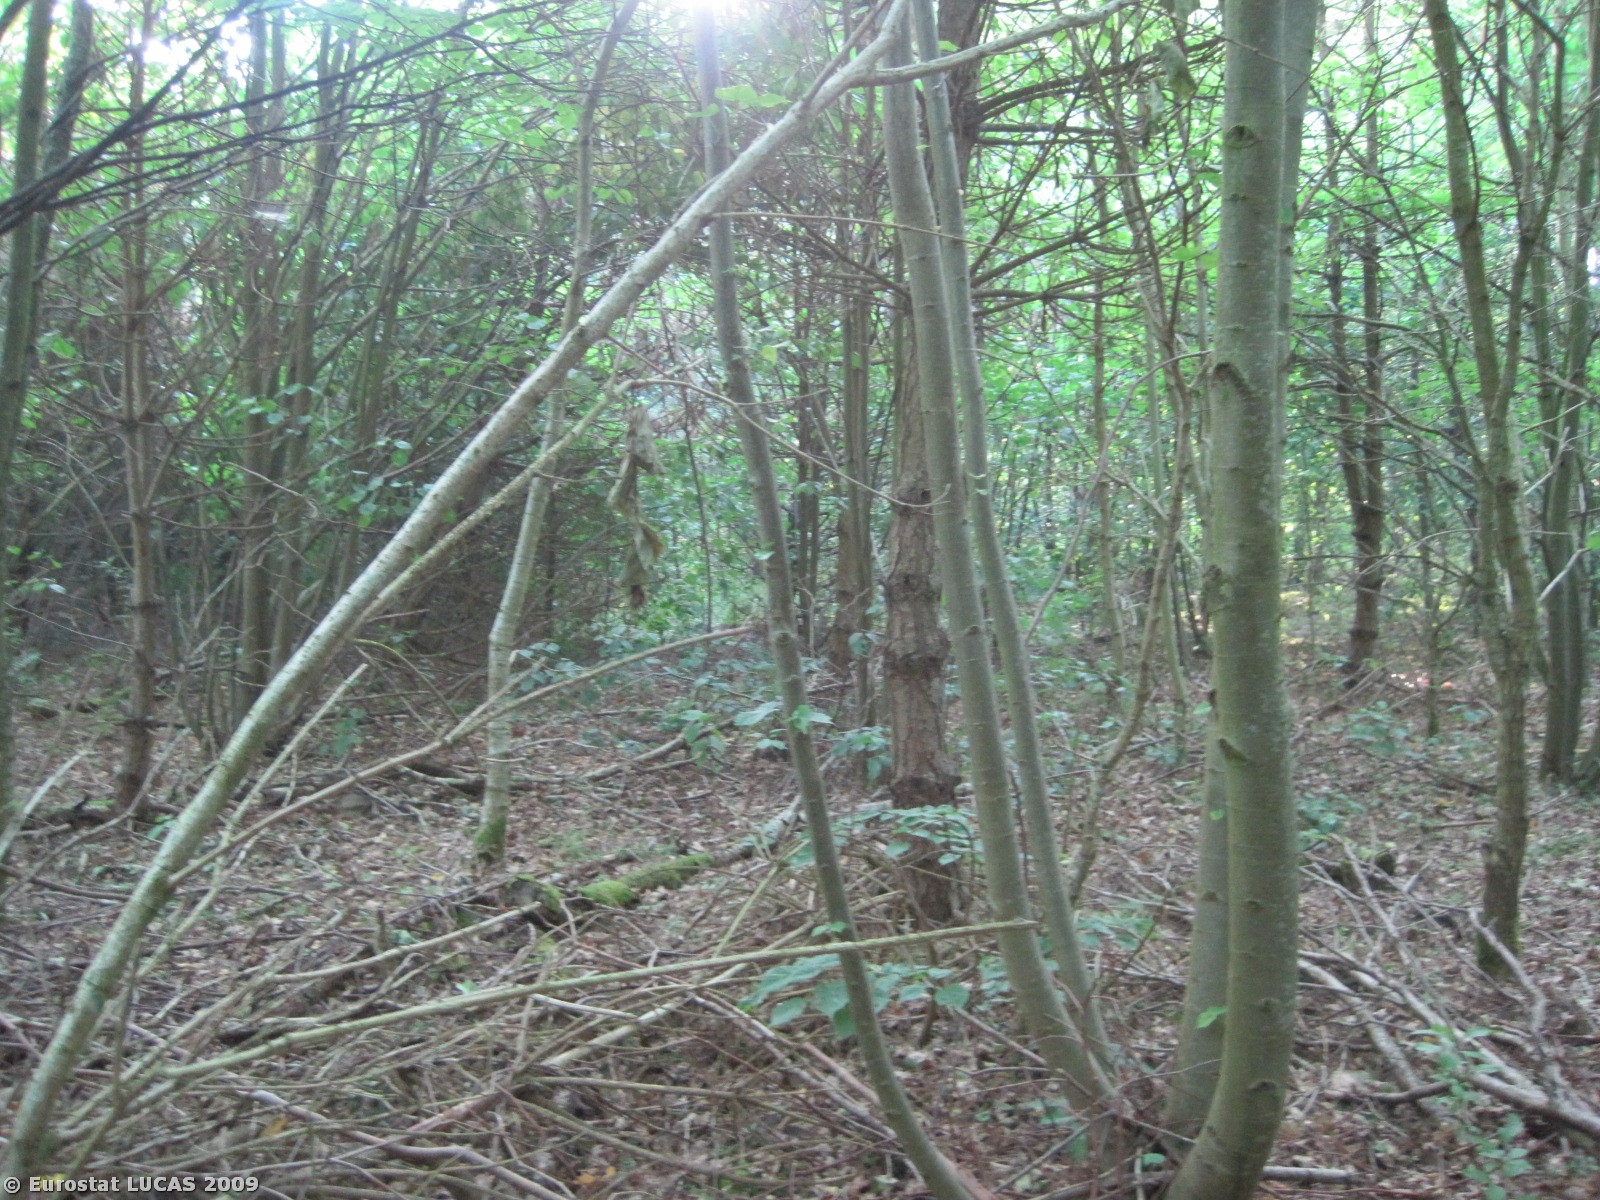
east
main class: Woodland
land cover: Broadleaved woodland
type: plantations and self-sown exotic forest
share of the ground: > 75 %
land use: Unused
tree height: > 5 m
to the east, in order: Broadleaved woodland; Grass margins; Fences; Grassland without tree/shrub cover; Fences; Grass margins; Ditches and canals; Shrubland with sparse tree cover; Grassland without tree/shrub cover; Broadleaved woodland; Mixed woodland; Grassland without tree/shrub cover
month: July
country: DK
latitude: 56.3747
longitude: 8.3342
